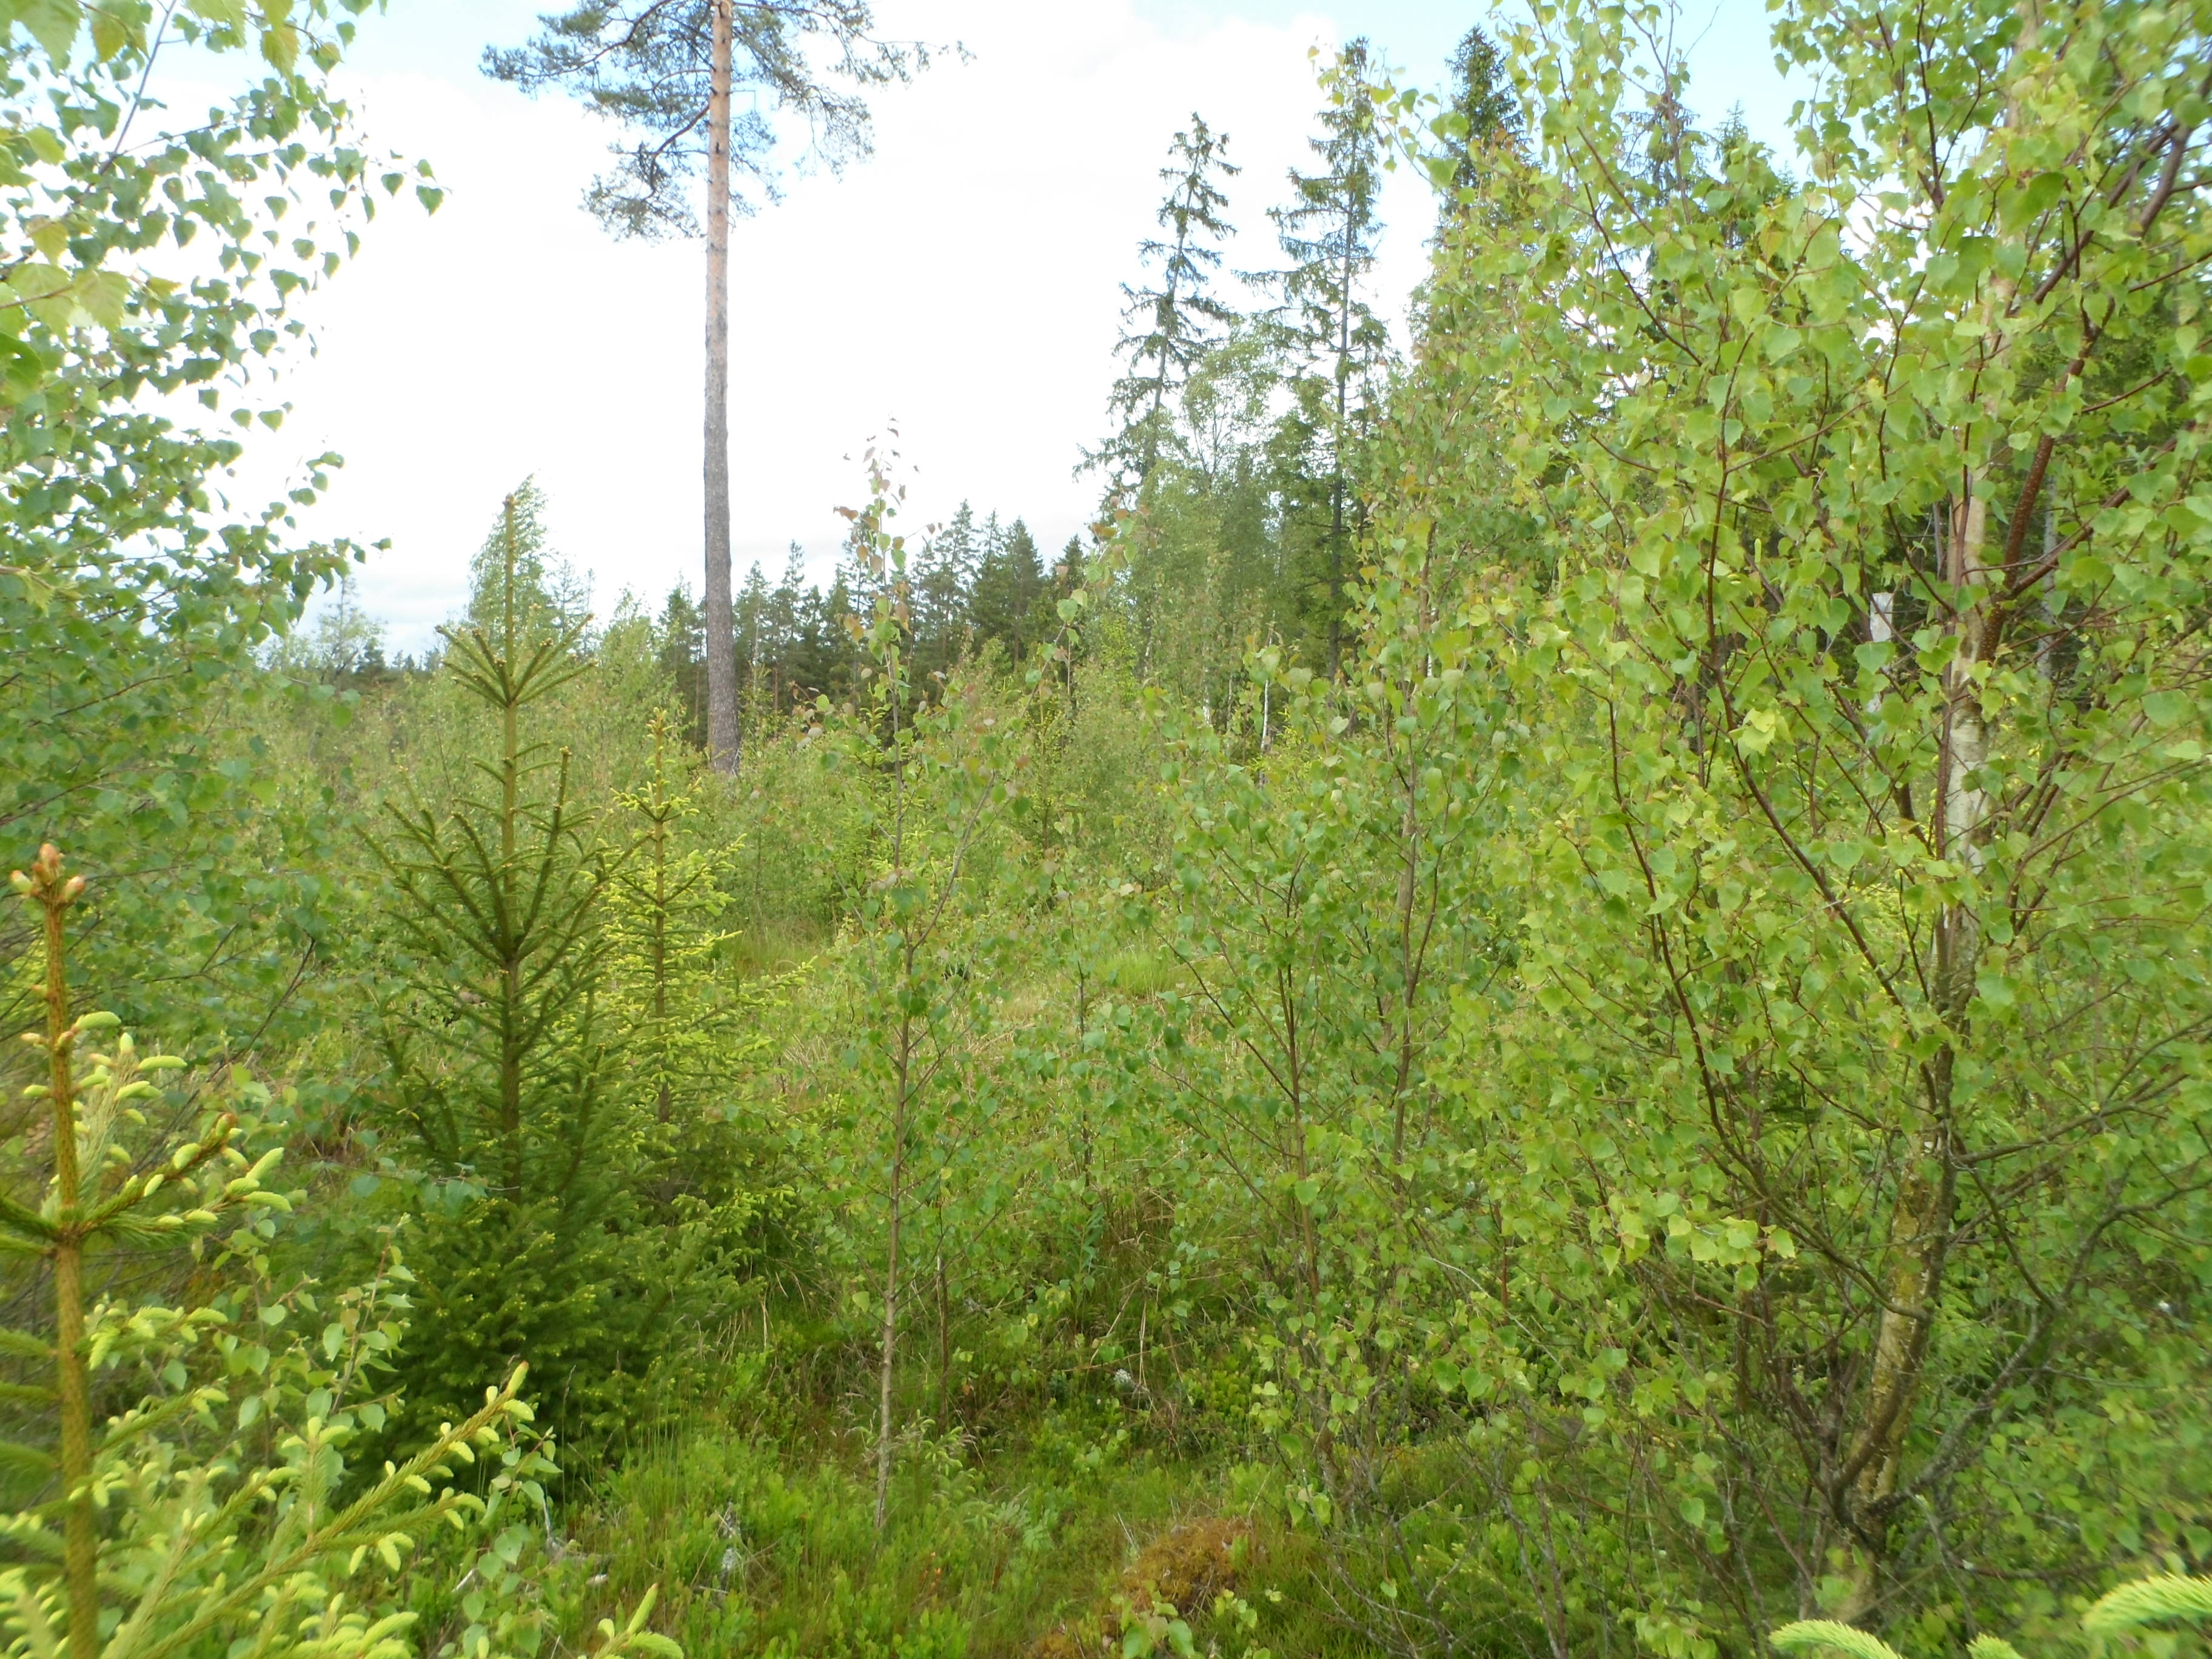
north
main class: Woodland
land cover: Spruce dominated mixed woodland
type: boreal forest
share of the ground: > 75 %
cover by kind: broadleaved forest trees 45 %, coniferous forest trees 35 %, shrubs 10 %, herbaceous plants 10 %
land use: Forestry
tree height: > 5 m
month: June
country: SE
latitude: 57.0096
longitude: 14.4921
